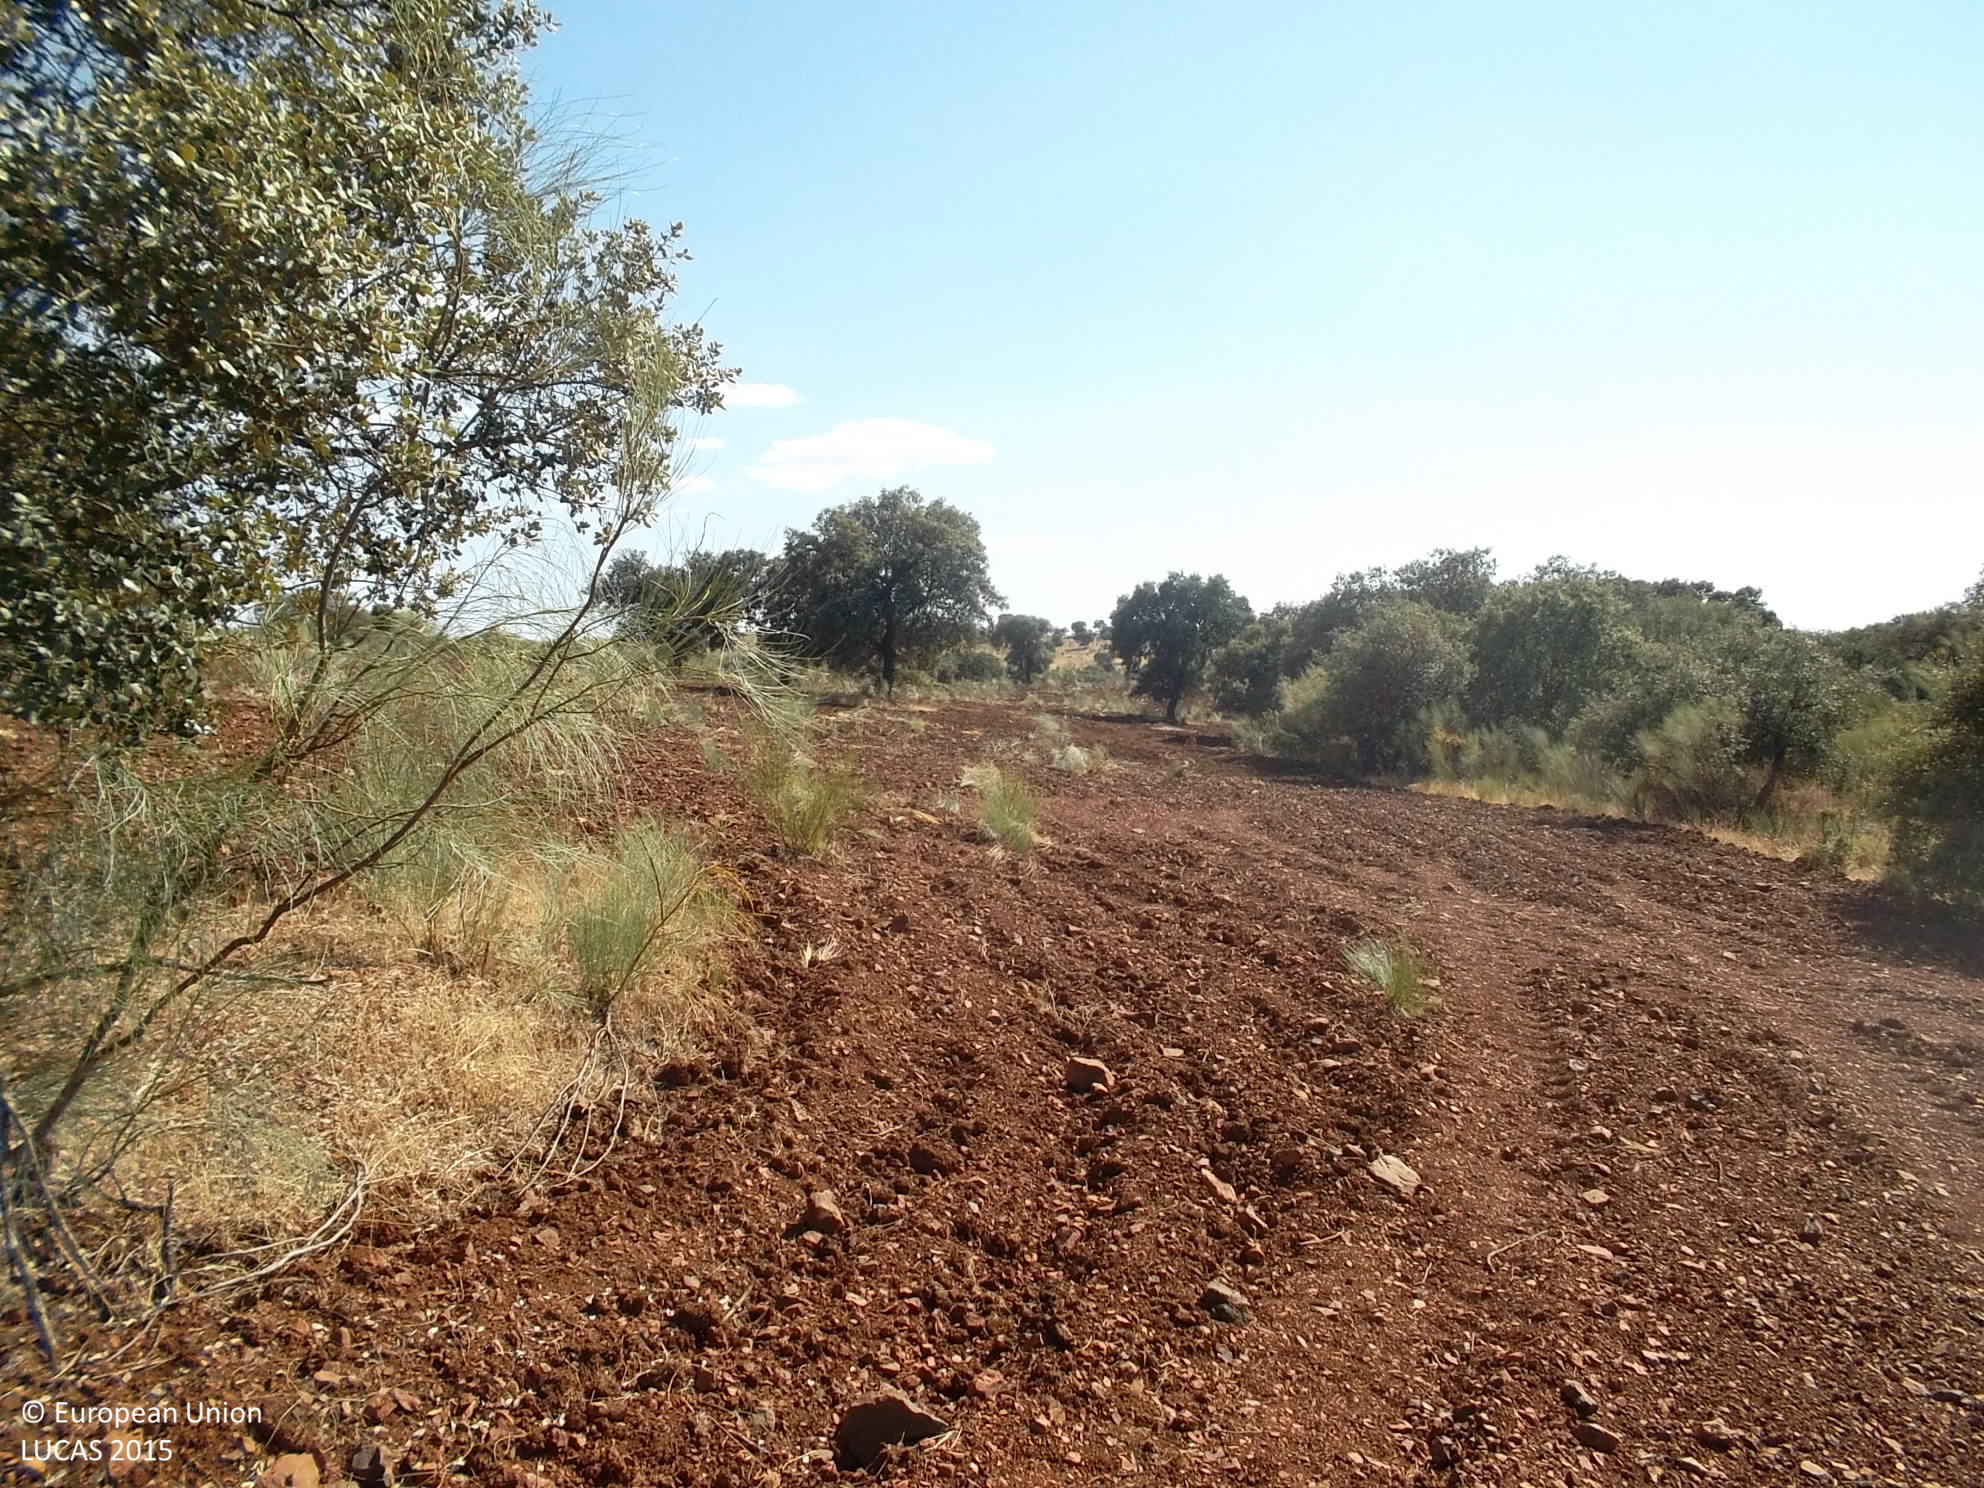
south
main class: Woodland
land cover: Broadleaved woodland
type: broadleaved evergreen forest
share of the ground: 10 - 25 %
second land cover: Spontaneously vegetated surfaces
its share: 10 - 25 %
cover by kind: unconsolidated bare surface 60 %, broadleaved forest trees 25 %, shrubs 15 %
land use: Agriculture (excluding fallow land and kitchen gardens)
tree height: > 5 m
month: July
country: ES
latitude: 38.5627
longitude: -5.7518
